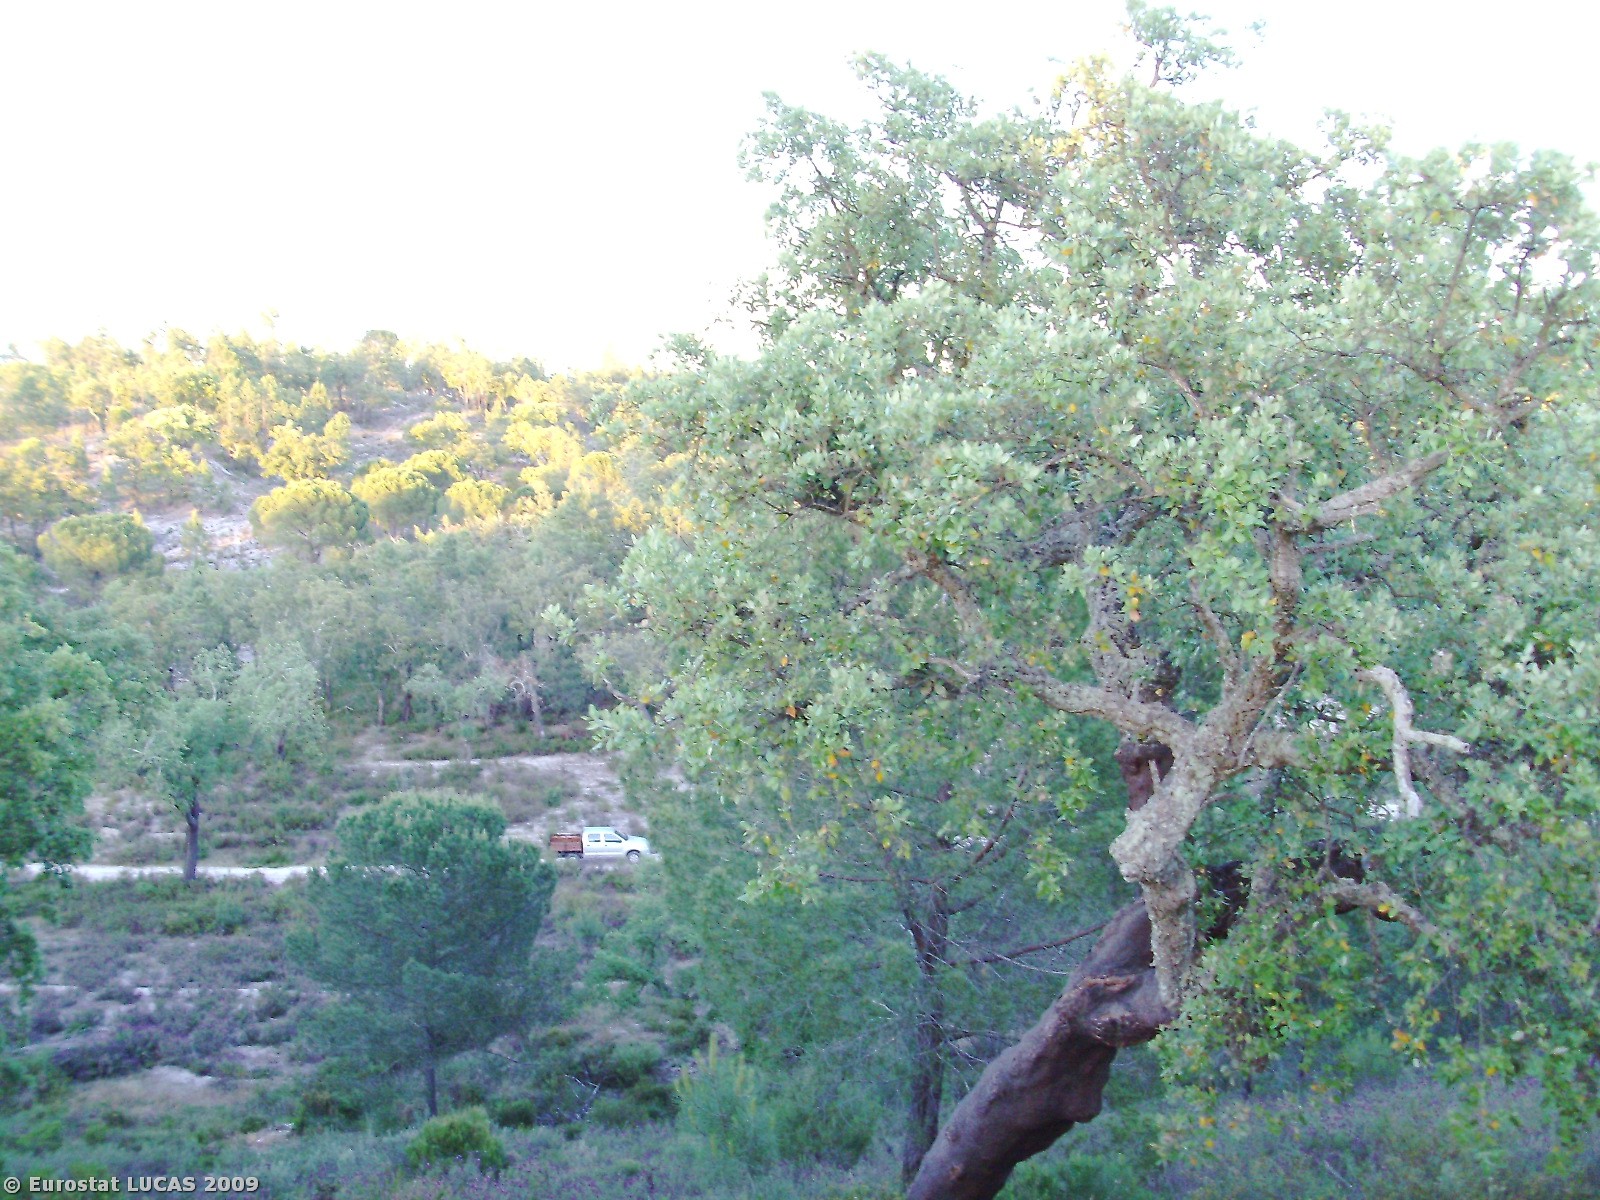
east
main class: Woodland
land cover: Broadleaved woodland
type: broadleaved evergreen forest
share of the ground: 25 - 50 %
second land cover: Spontaneously vegetated surfaces
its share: 50 - 75 %
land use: Forestry
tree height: > 5 m
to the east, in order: Broadleaved woodland; Spontaneously vegetated surfaces; Broadleaved woodland; Tracks; Broadleaved woodland
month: May
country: PT
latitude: 39.1771
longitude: -8.0072
